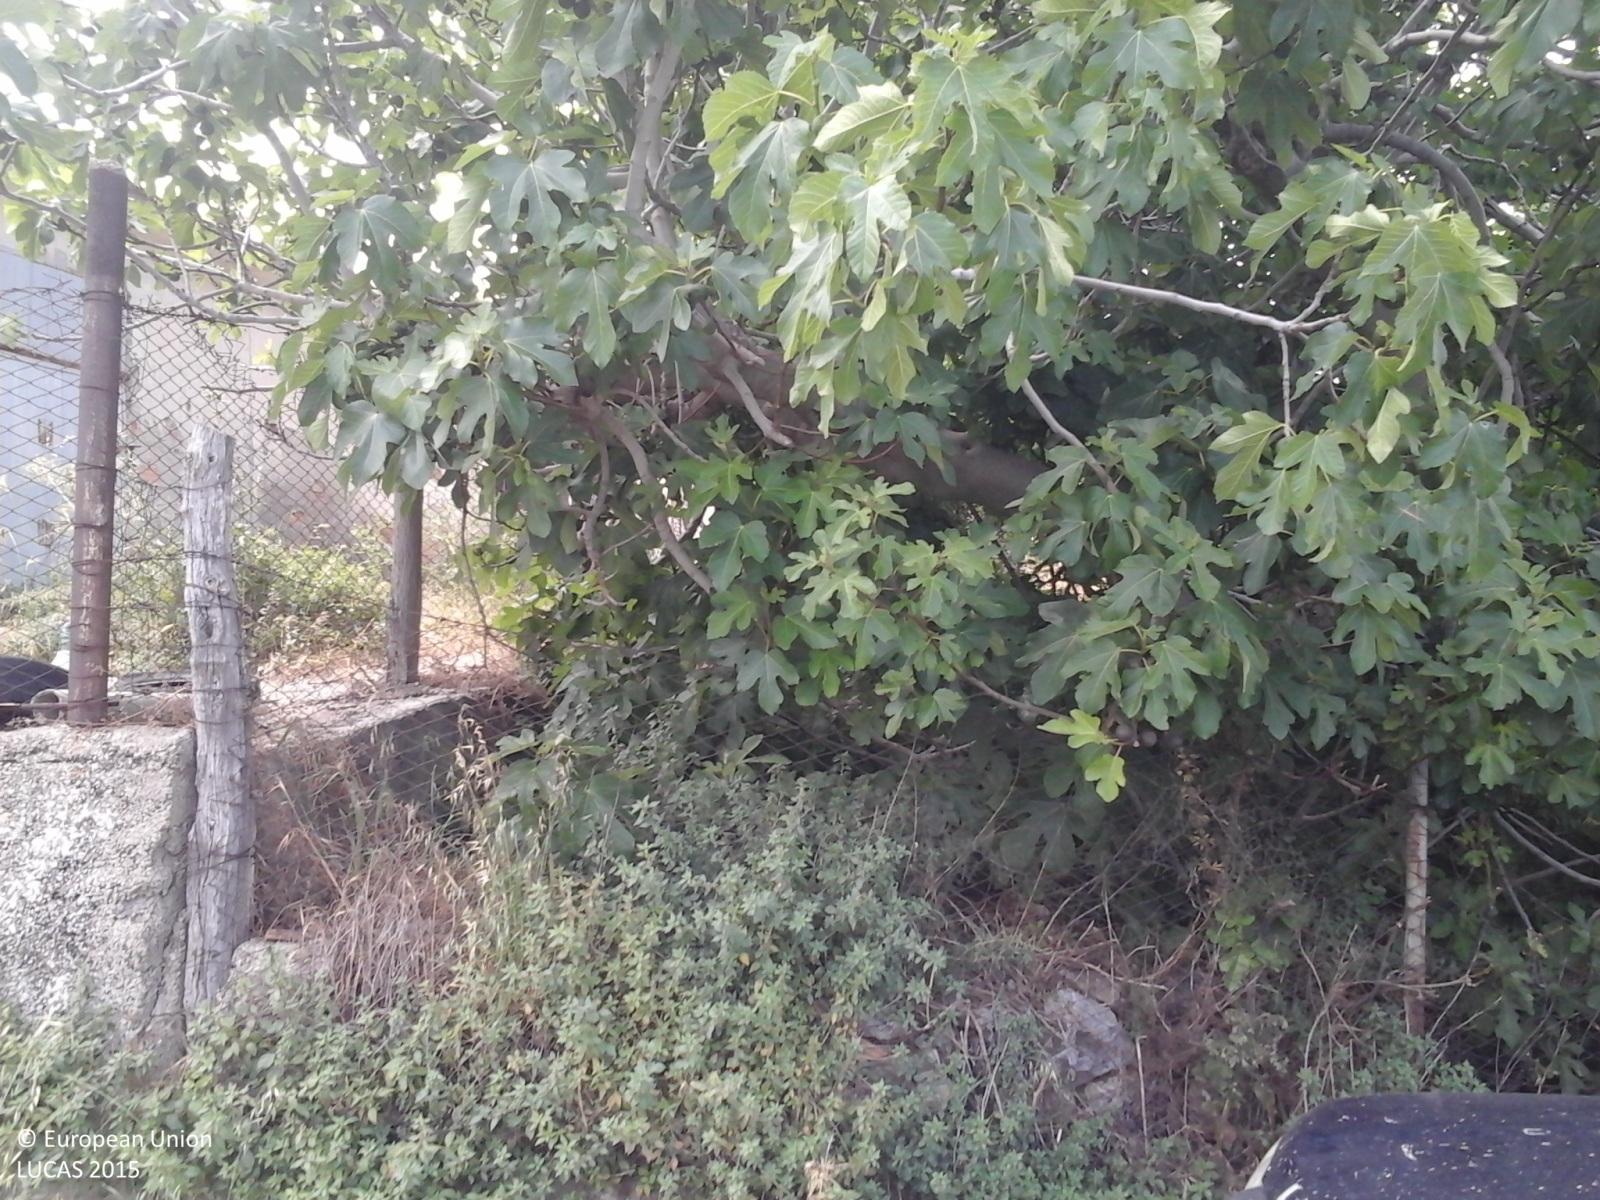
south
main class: Grassland
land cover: Grassland with sparse tree/shrub cover
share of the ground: > 75 %
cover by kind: herbaceous plants 85 %, shrubs 10 %, broadleaved forest trees 5 %
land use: Agriculture (excluding fallow land and kitchen gardens)
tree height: < 5 m
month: June
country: IT
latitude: 37.8849
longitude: 13.9176
